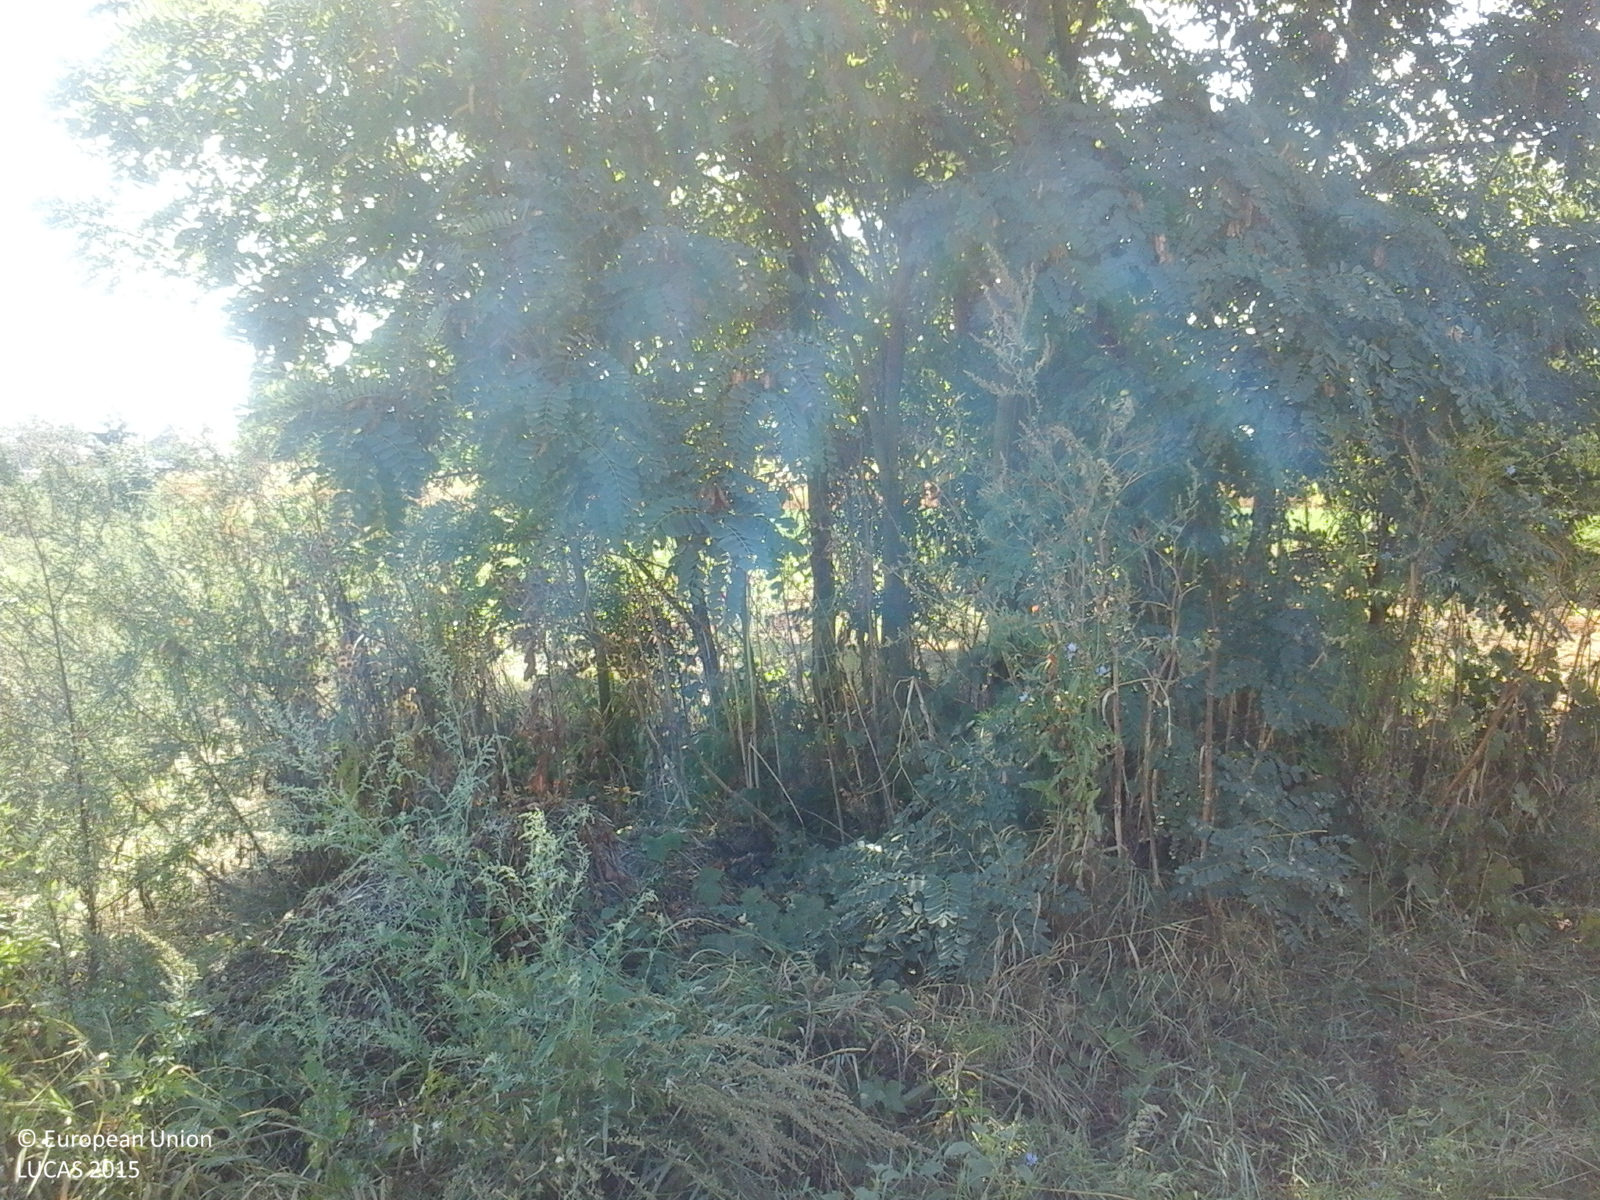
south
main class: Cropland
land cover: Maize
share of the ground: > 75 %
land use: Agriculture (excluding fallow land and kitchen gardens)
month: September
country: RO
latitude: 47.7989
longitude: 22.9766
